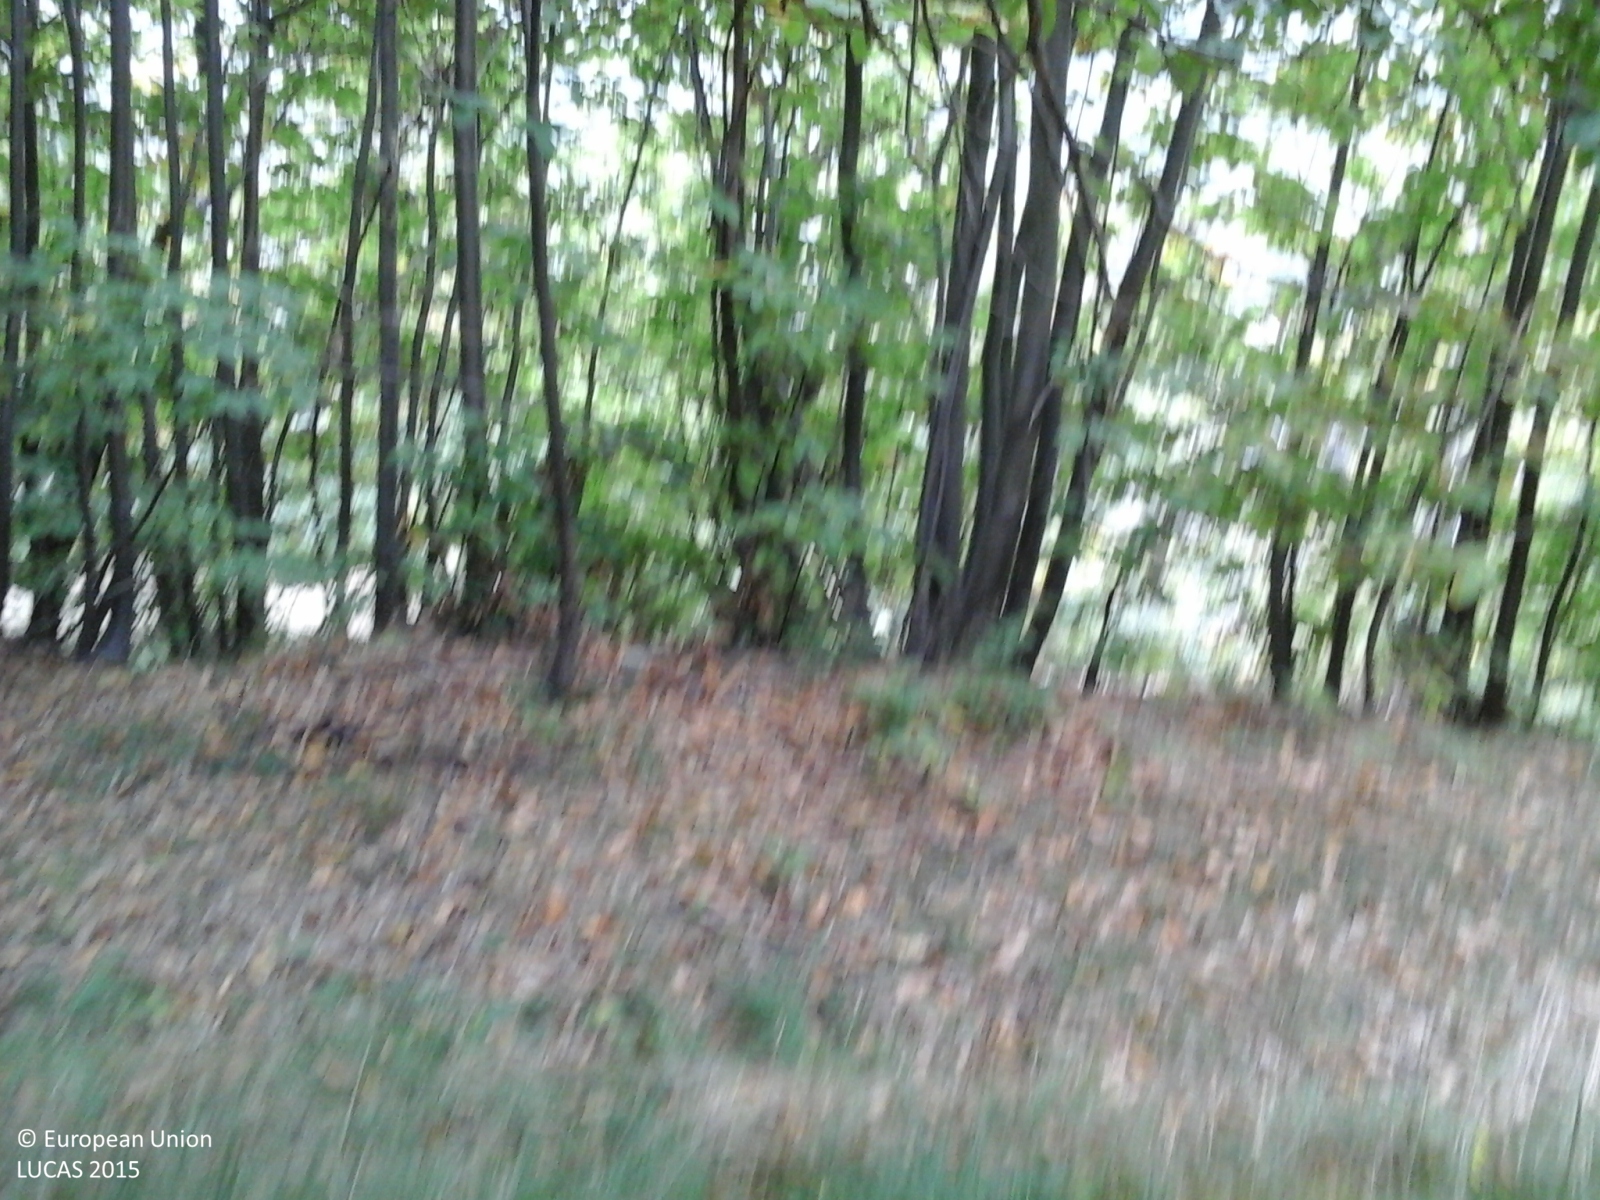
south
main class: Cropland
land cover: Nuts trees
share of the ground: > 75 %
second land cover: Grassland without tree/shrub cover
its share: > 75 %
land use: Agriculture (excluding fallow land and kitchen gardens)
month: September
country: IT
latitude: 44.2806
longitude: 8.1872
